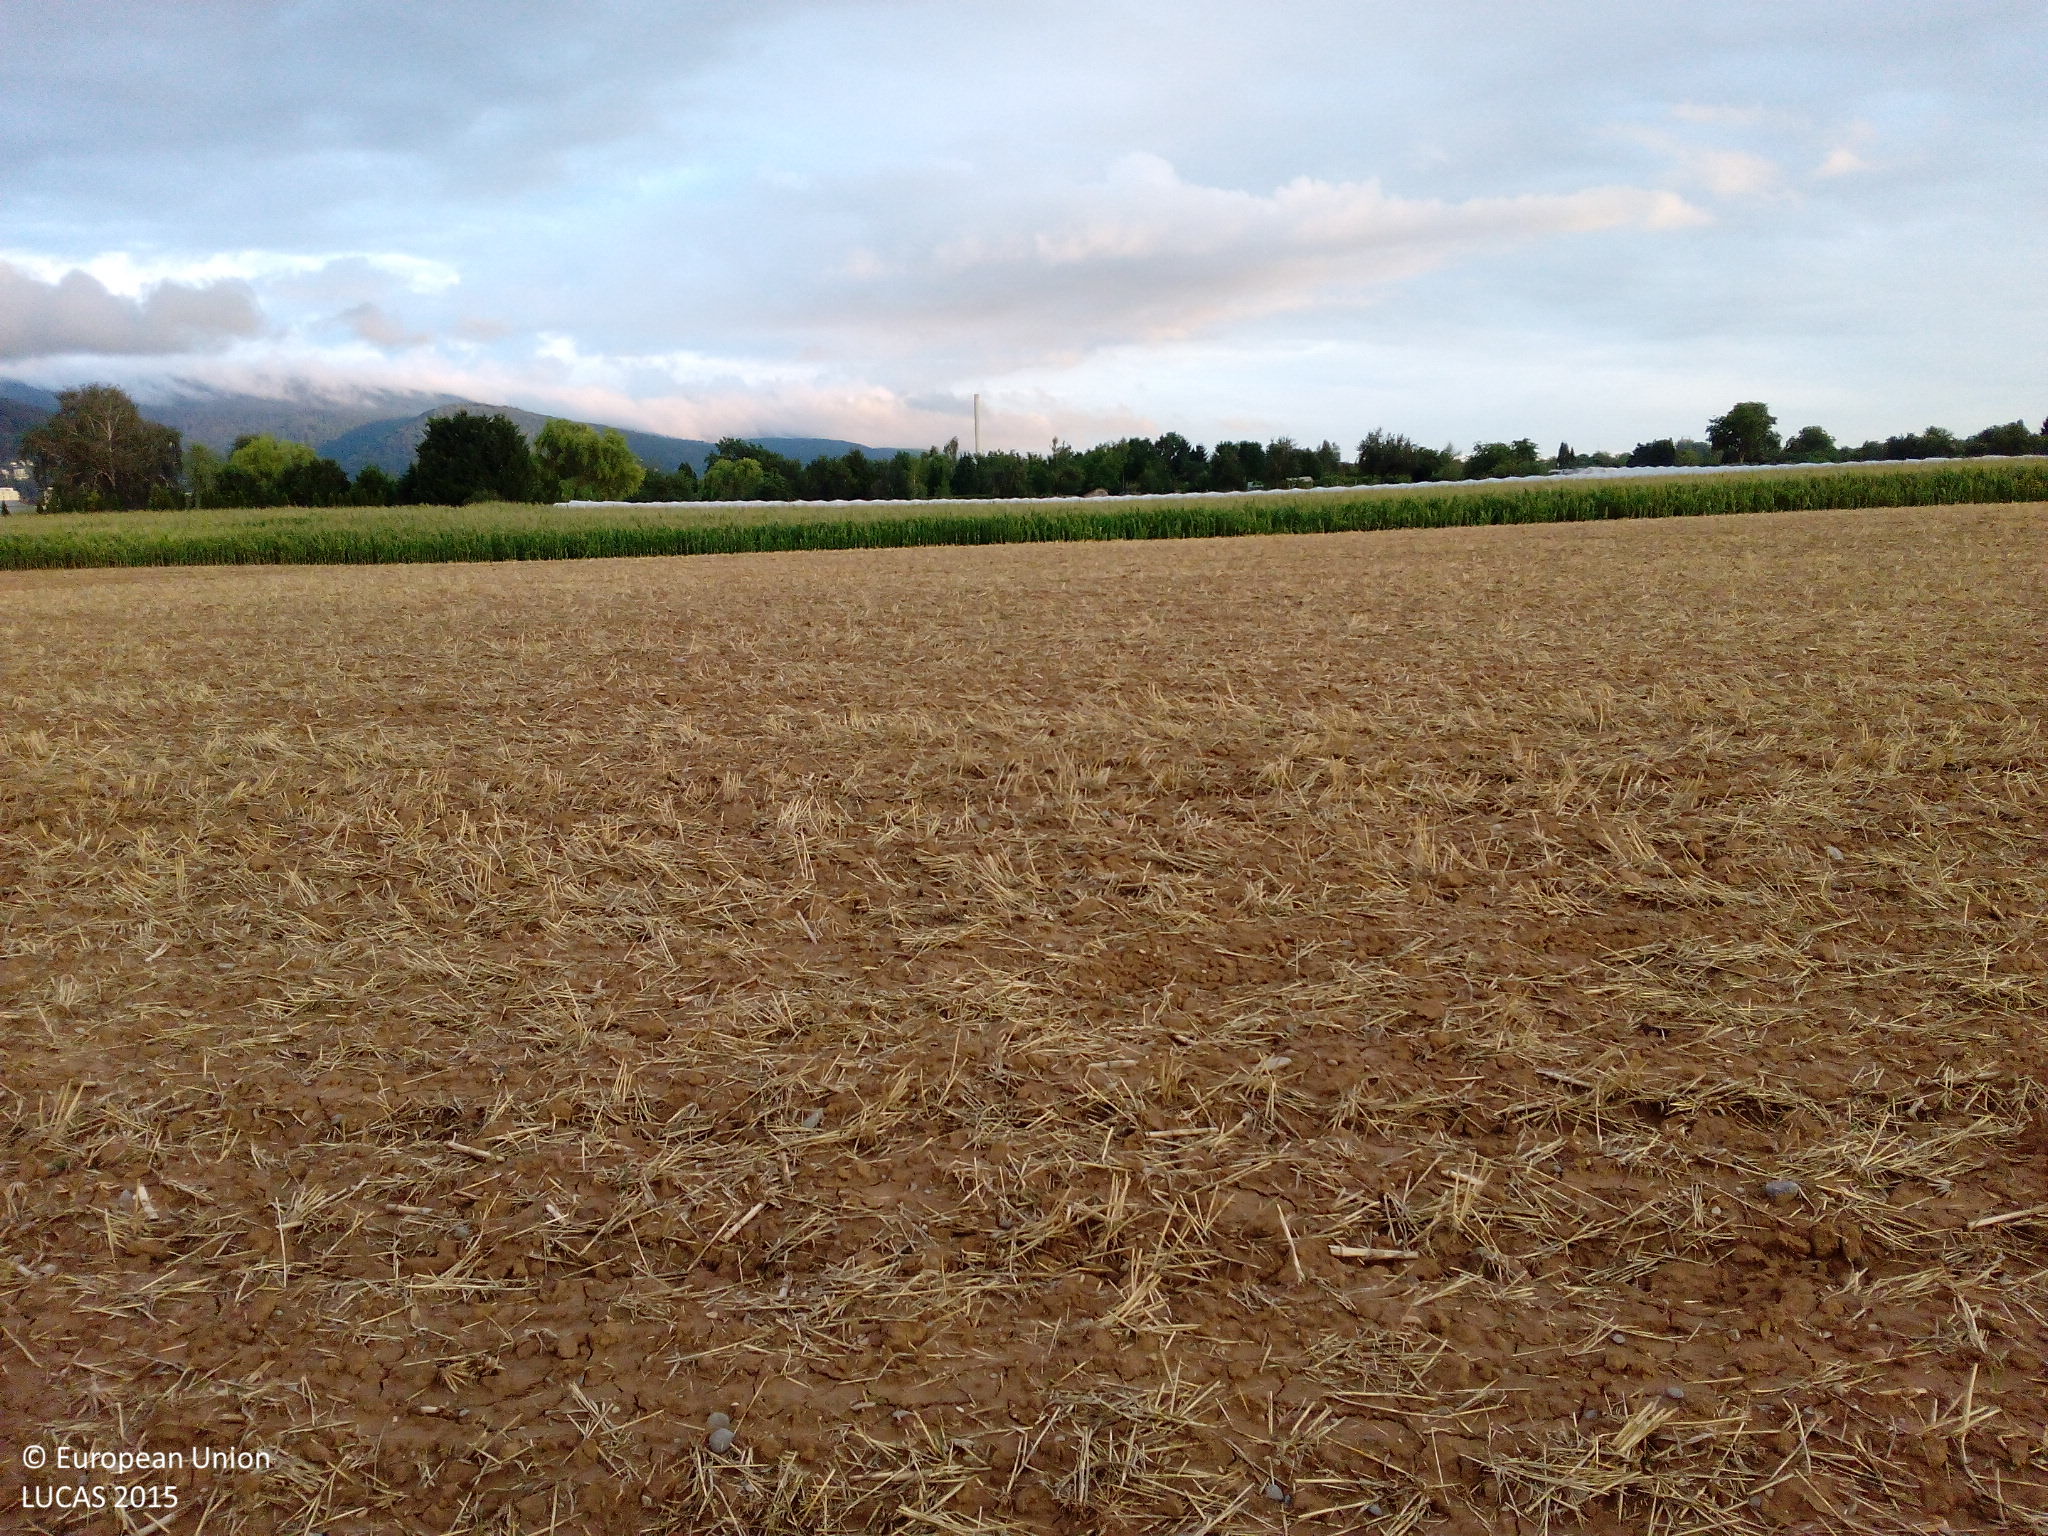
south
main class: Cropland
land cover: Maize
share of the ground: > 75 %
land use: Agriculture (excluding fallow land and kitchen gardens)
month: August
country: DE
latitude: 49.4389
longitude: 8.6627
